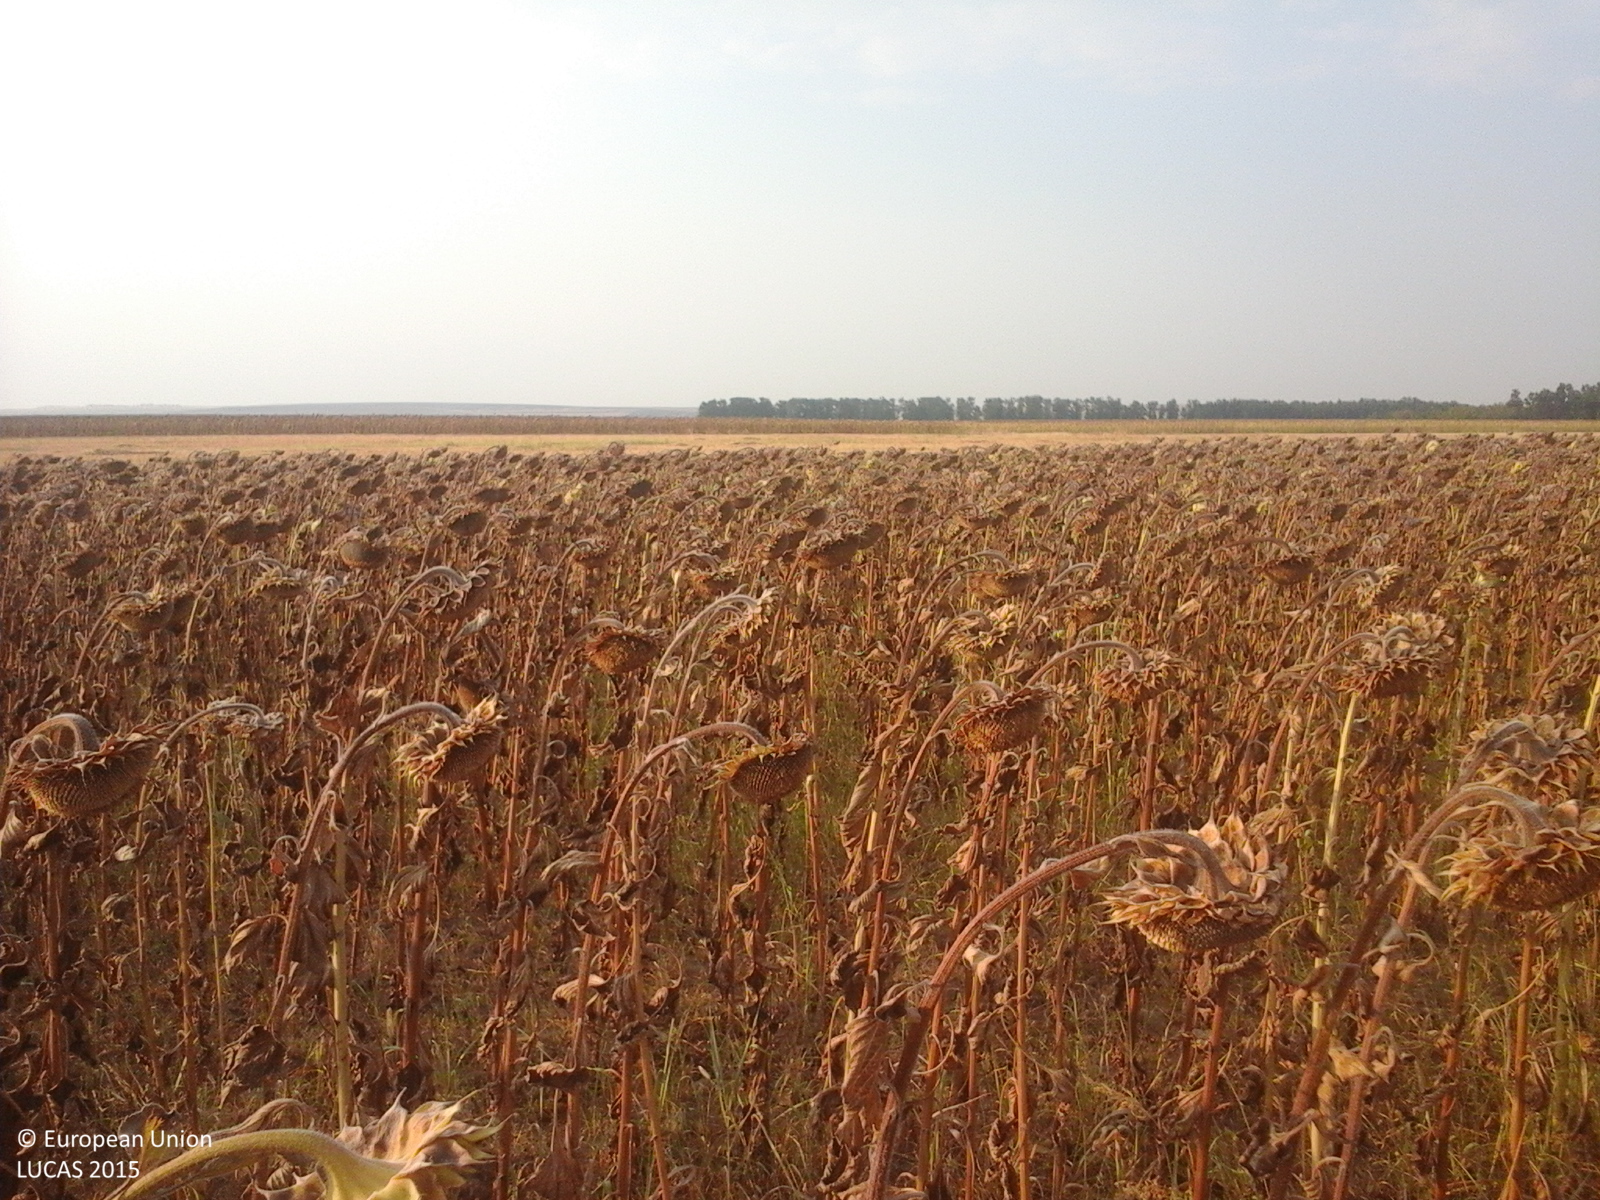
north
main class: Cropland
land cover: Sunflower
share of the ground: > 75 %
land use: Agriculture (excluding fallow land and kitchen gardens)
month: August
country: RO
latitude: 44.3173
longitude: 22.9702
